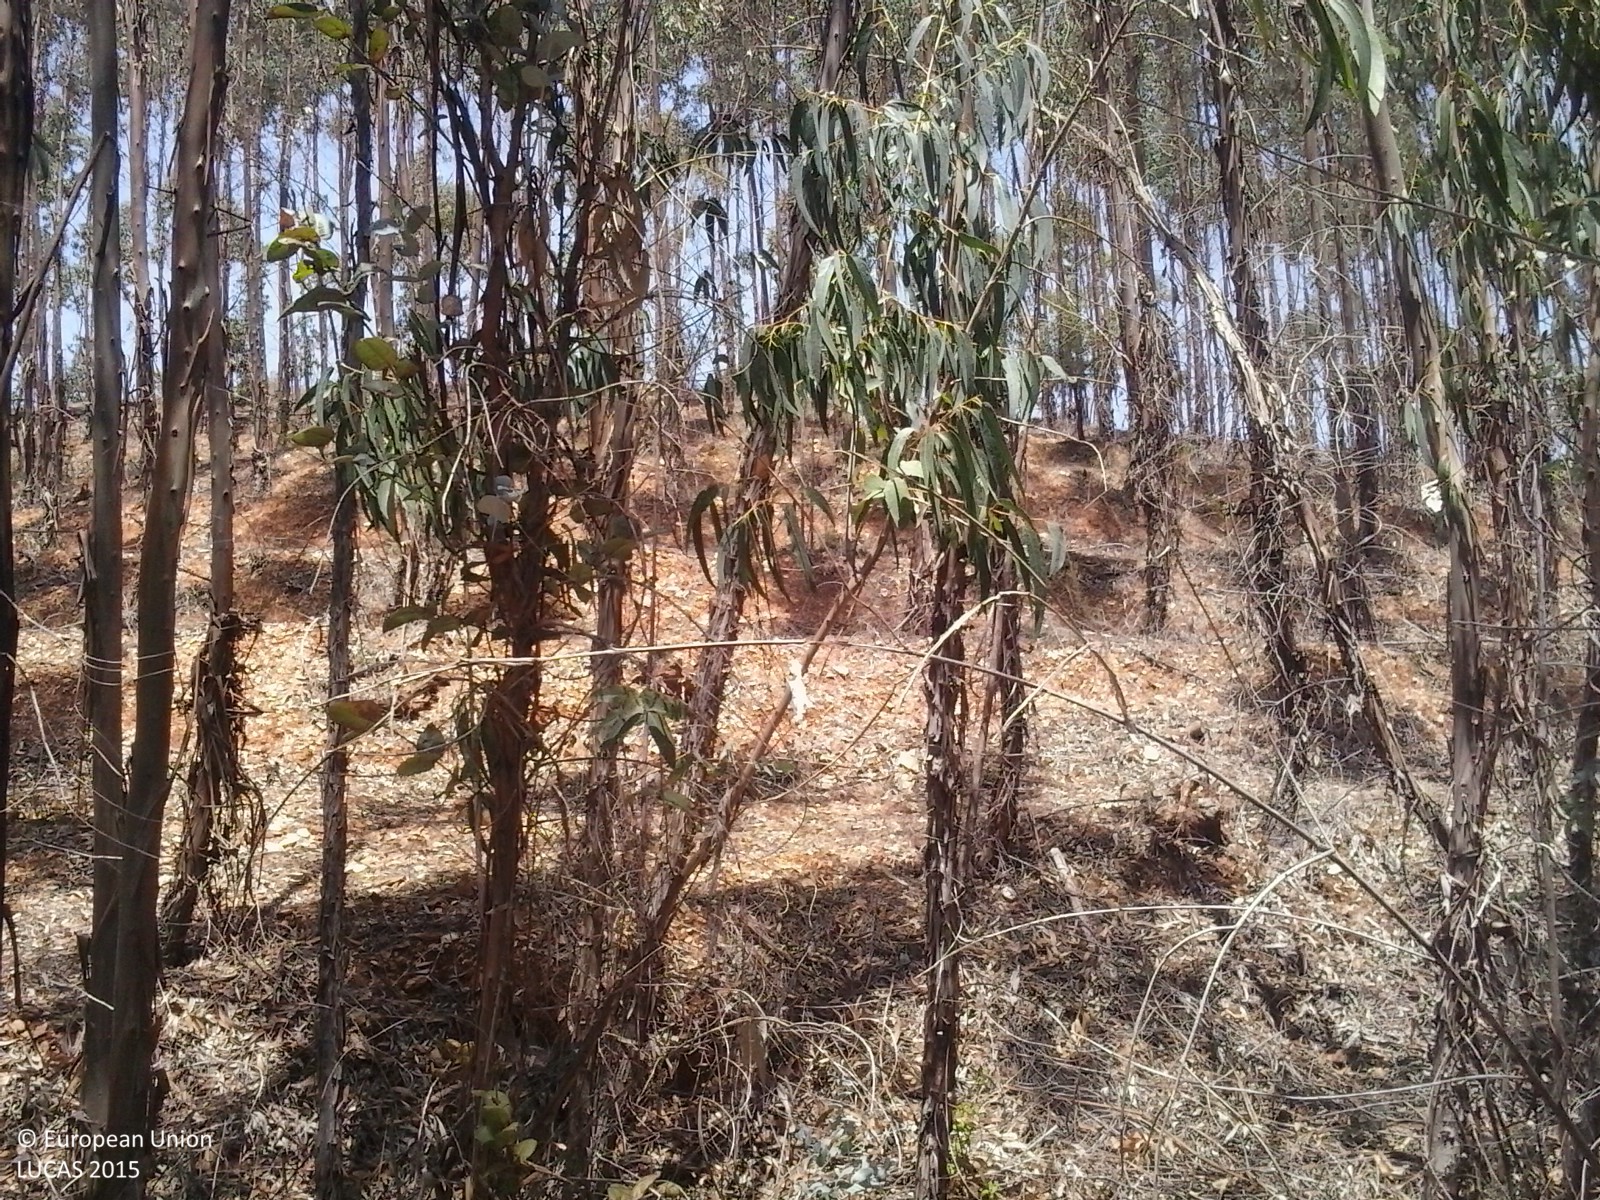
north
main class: Woodland
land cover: Broadleaved woodland
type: exotic forest
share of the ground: > 75 %
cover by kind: broadleaved forest trees 75 %, herbaceous plants 10 %, unconsolidated bare surface 10 %, shrubs 5 %
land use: Forestry
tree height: > 5 m
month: July
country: ES
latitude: 37.5435
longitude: -6.4342
